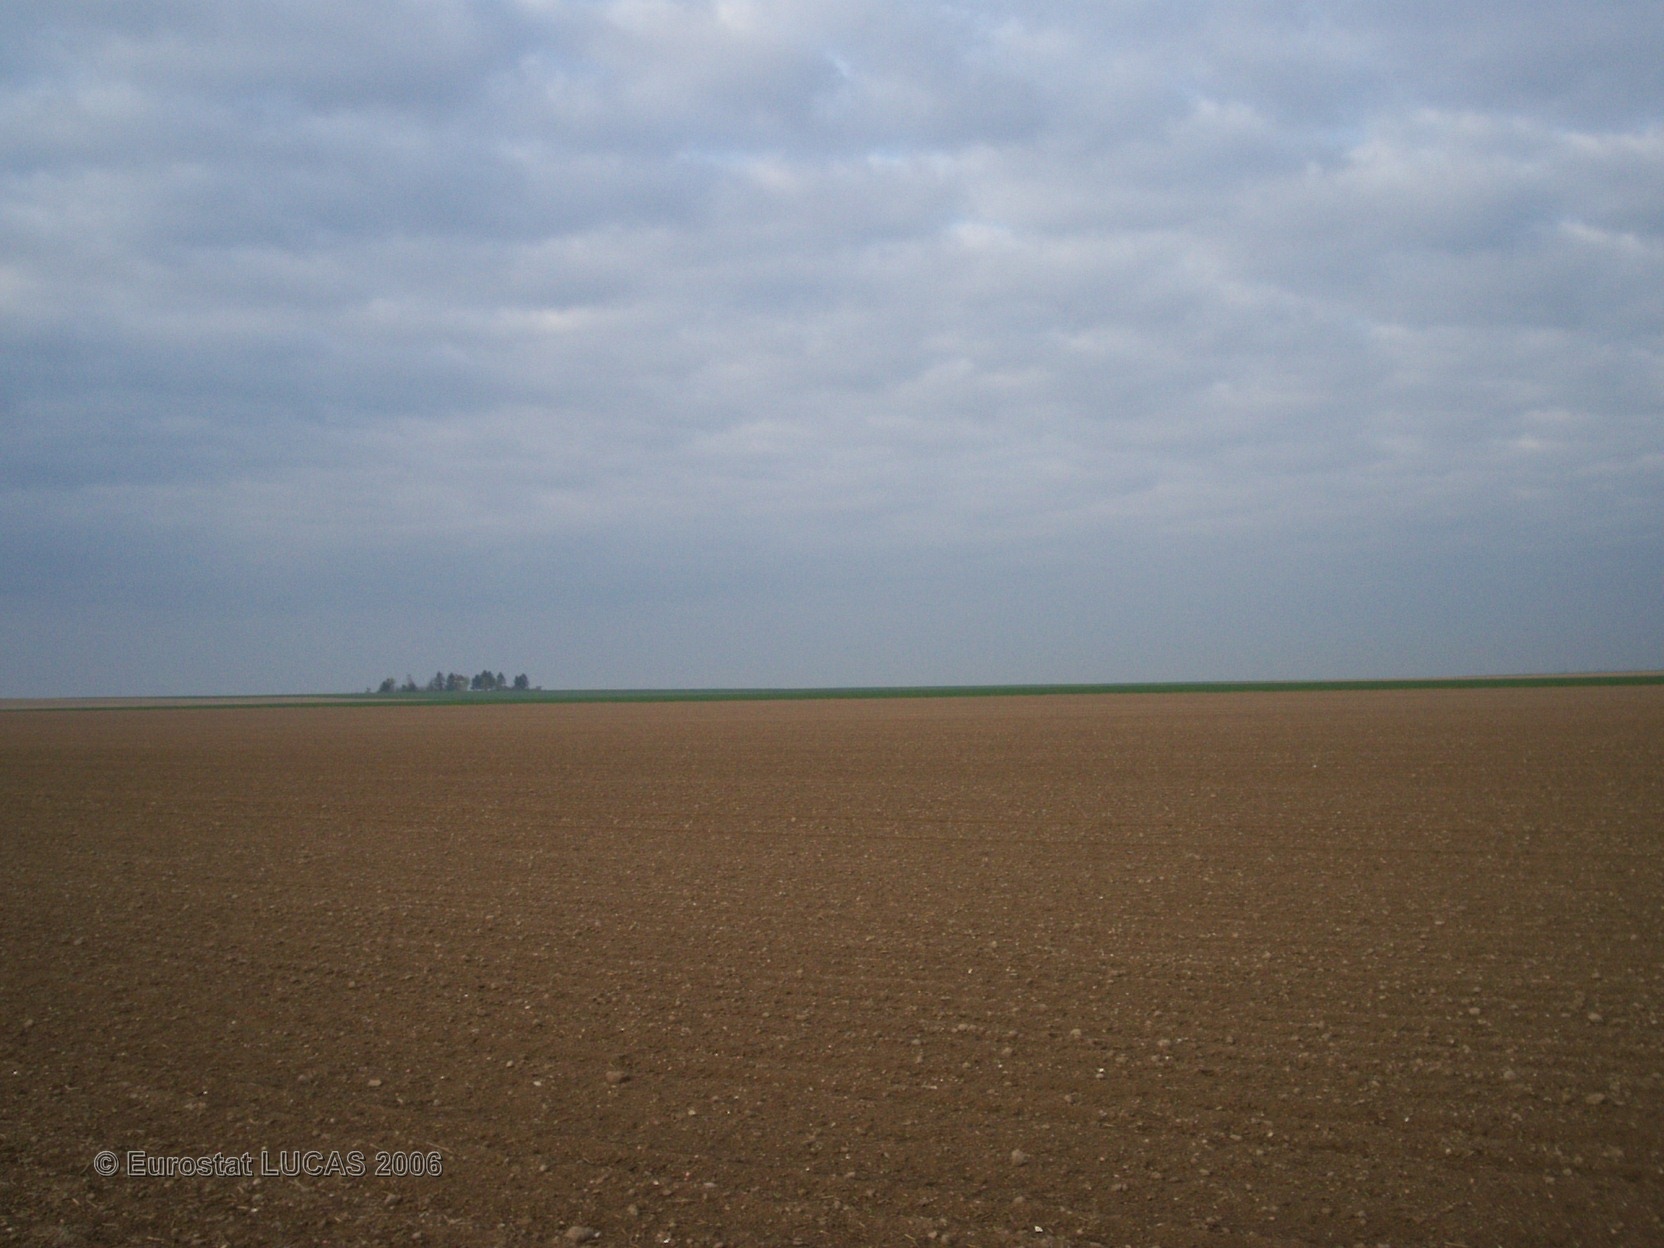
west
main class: Cropland
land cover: Dry pulses
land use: Agriculture (excluding fallow land and kitchen gardens)
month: April
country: FR
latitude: 48.7247
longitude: 3.9460
